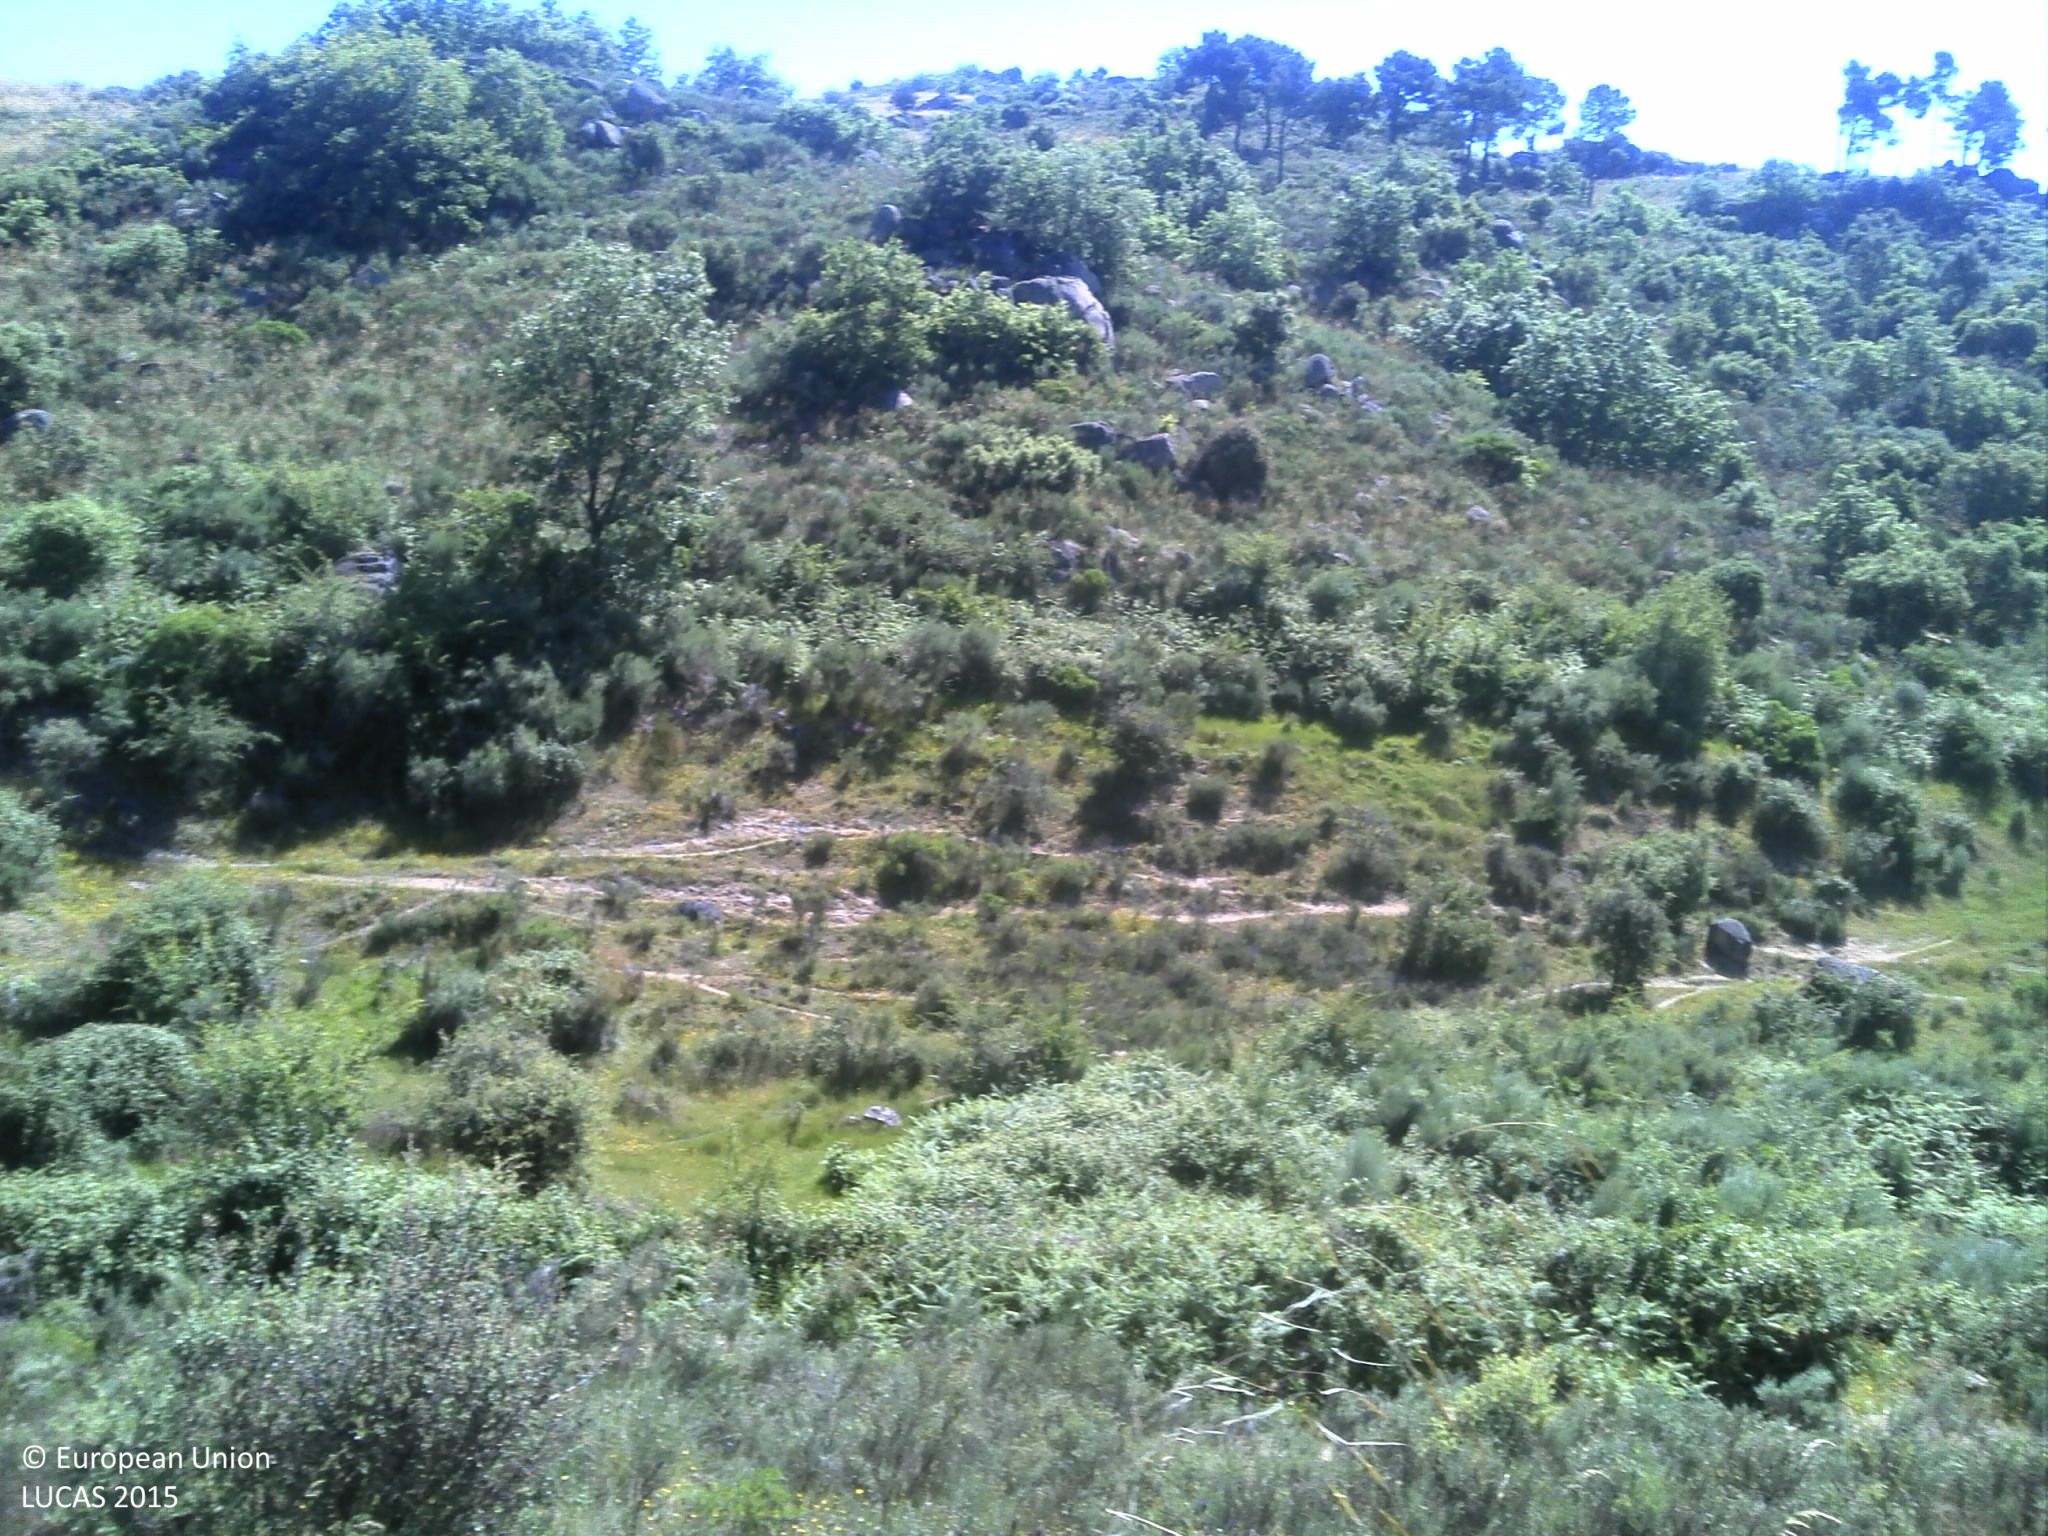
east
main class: Shrubland
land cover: Shrubland without tree cover
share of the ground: 50 - 75 %
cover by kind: shrubs 75 %, herbaceous plants 15 %, unconsolidated bare surface 10 %
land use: Abandoned areas
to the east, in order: Shrubland without tree cover; Tracks; Shrubland without tree cover; Rivers and streams; Shrubland with sparse tree cover; Rocks and stones; Shrubland with sparse tree cover; Pine dominated coniferous woodland
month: May
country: PT
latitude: 40.6730
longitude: -7.2981
